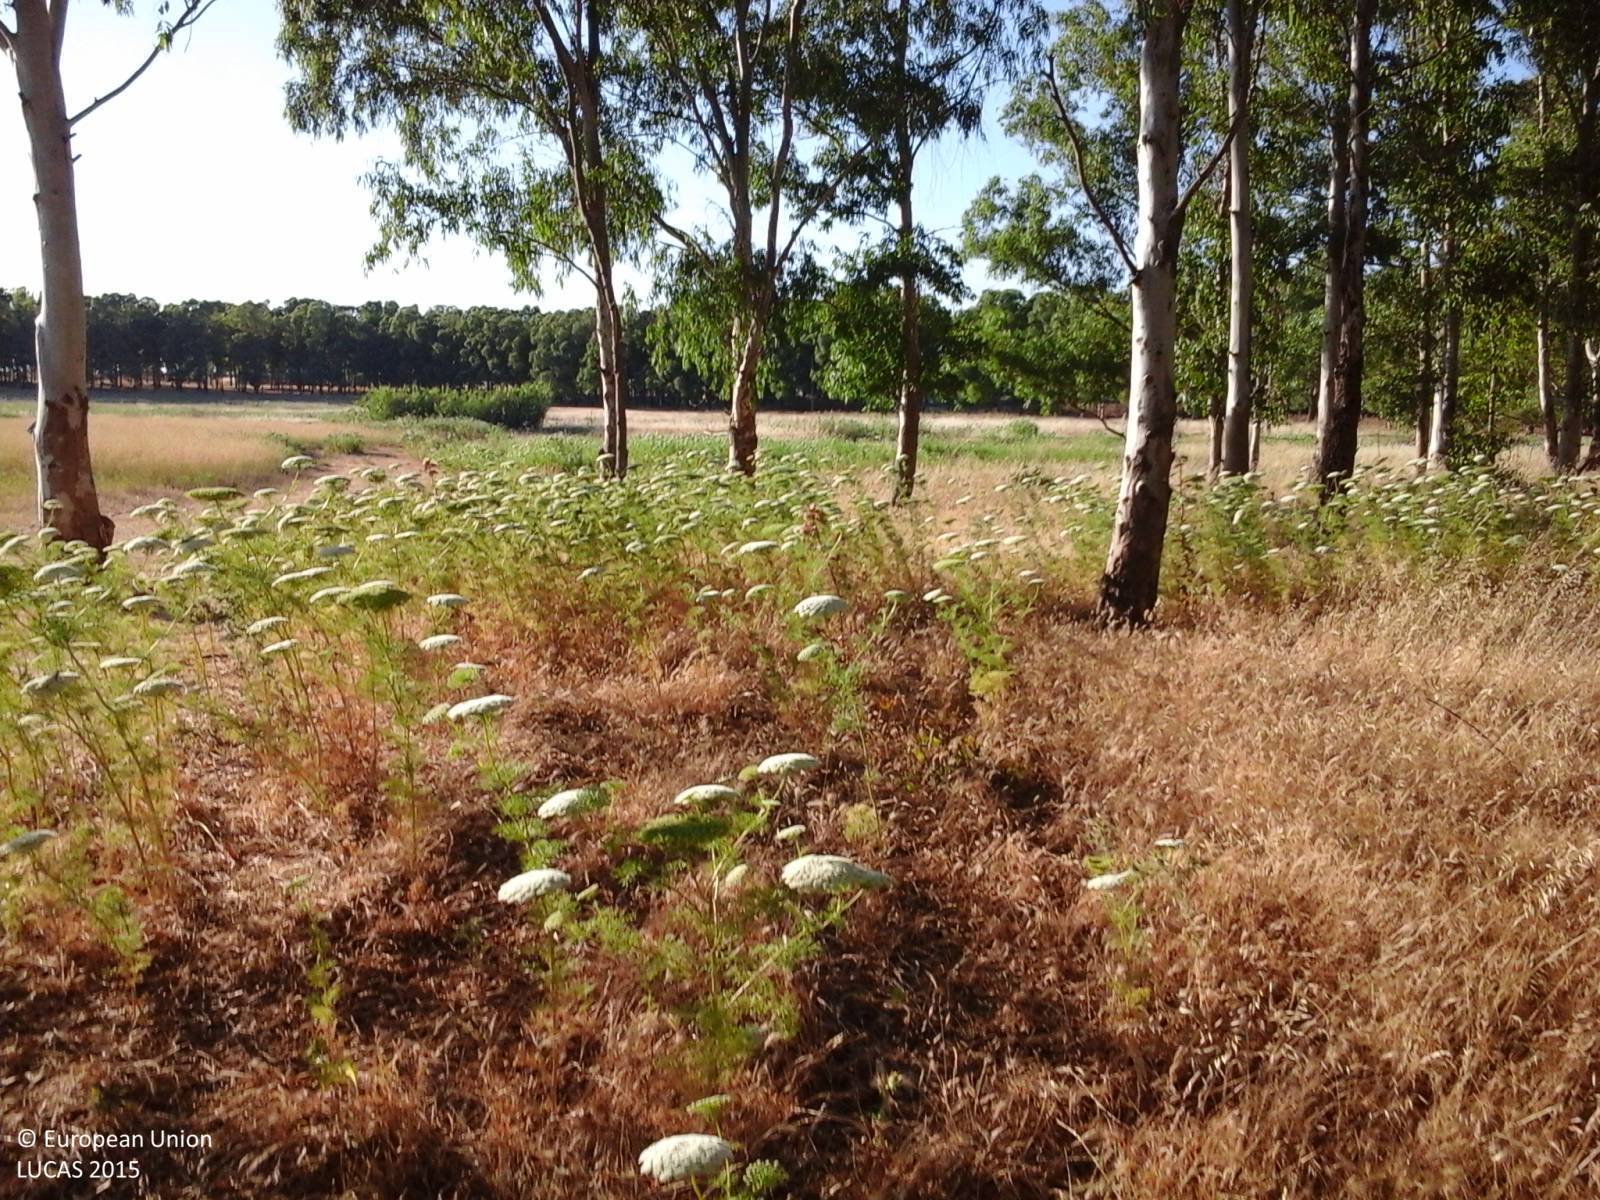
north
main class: Woodland
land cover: Broadleaved woodland
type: broadleaved evergreen forest
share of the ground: 25 - 50 %
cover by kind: broadleaved forest trees 50 %, herbaceous plants 50 %
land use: Forestry
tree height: > 5 m
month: June
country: IT
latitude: 37.9666
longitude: 12.5878
